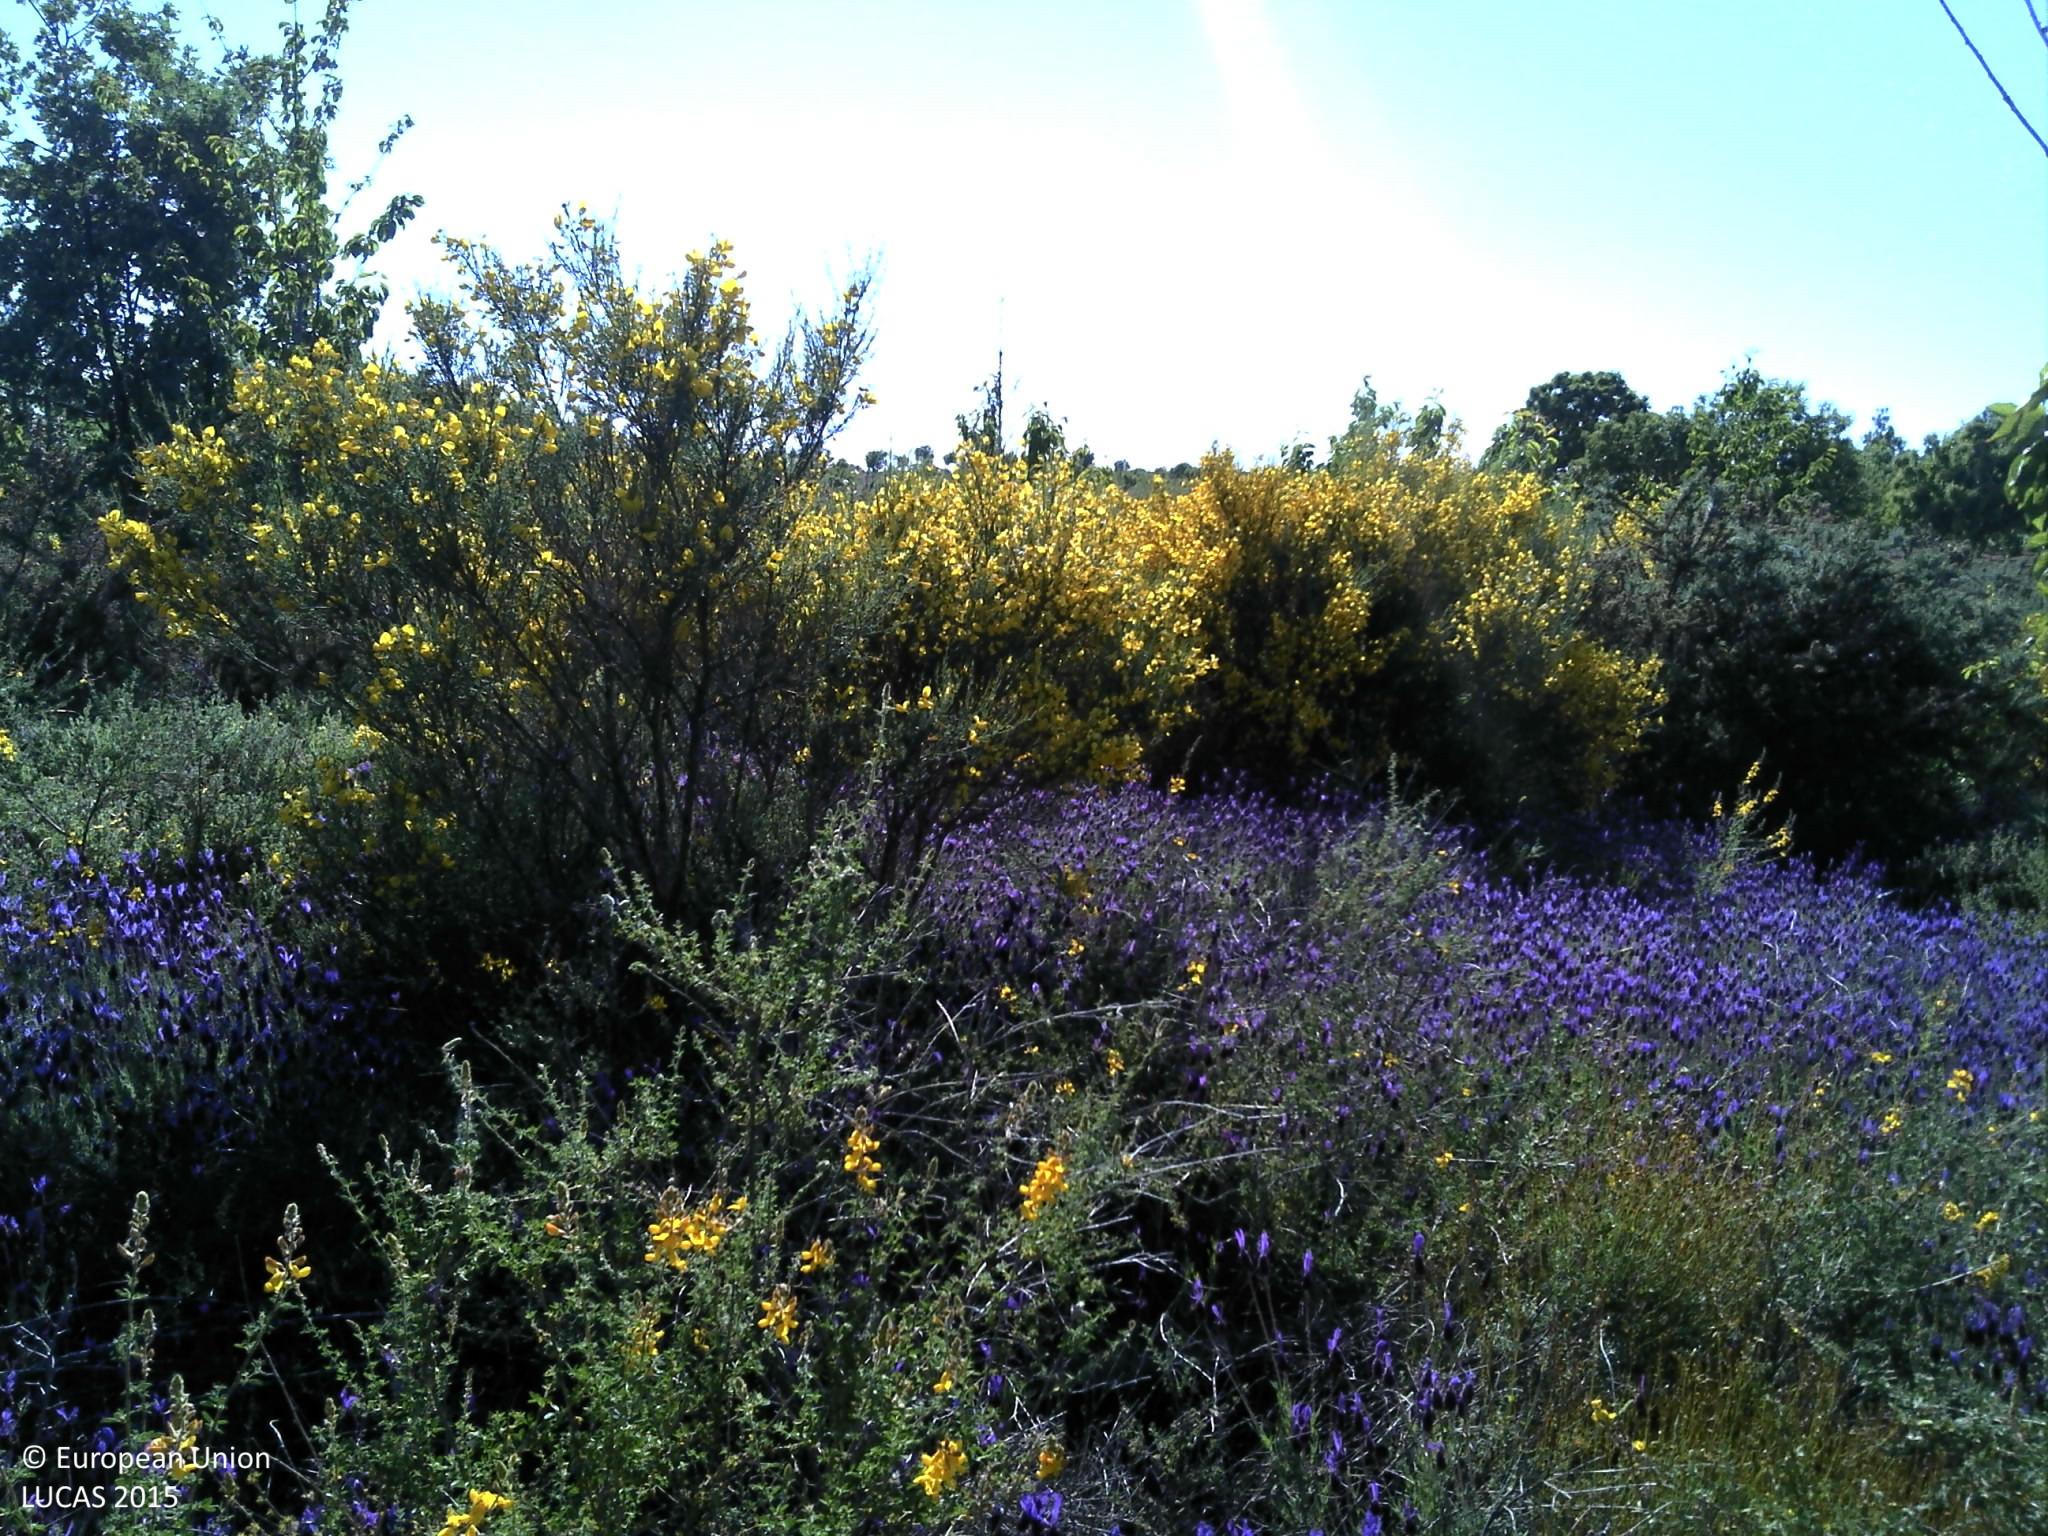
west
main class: Shrubland
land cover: Shrubland with sparse tree cover
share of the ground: > 75 %
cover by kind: shrubs 90 %, broadleaved forest trees 5 %, herbaceous plants 5 %
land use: Abandoned areas
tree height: < 5 m
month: May
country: PT
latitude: 41.6427
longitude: -6.3698
